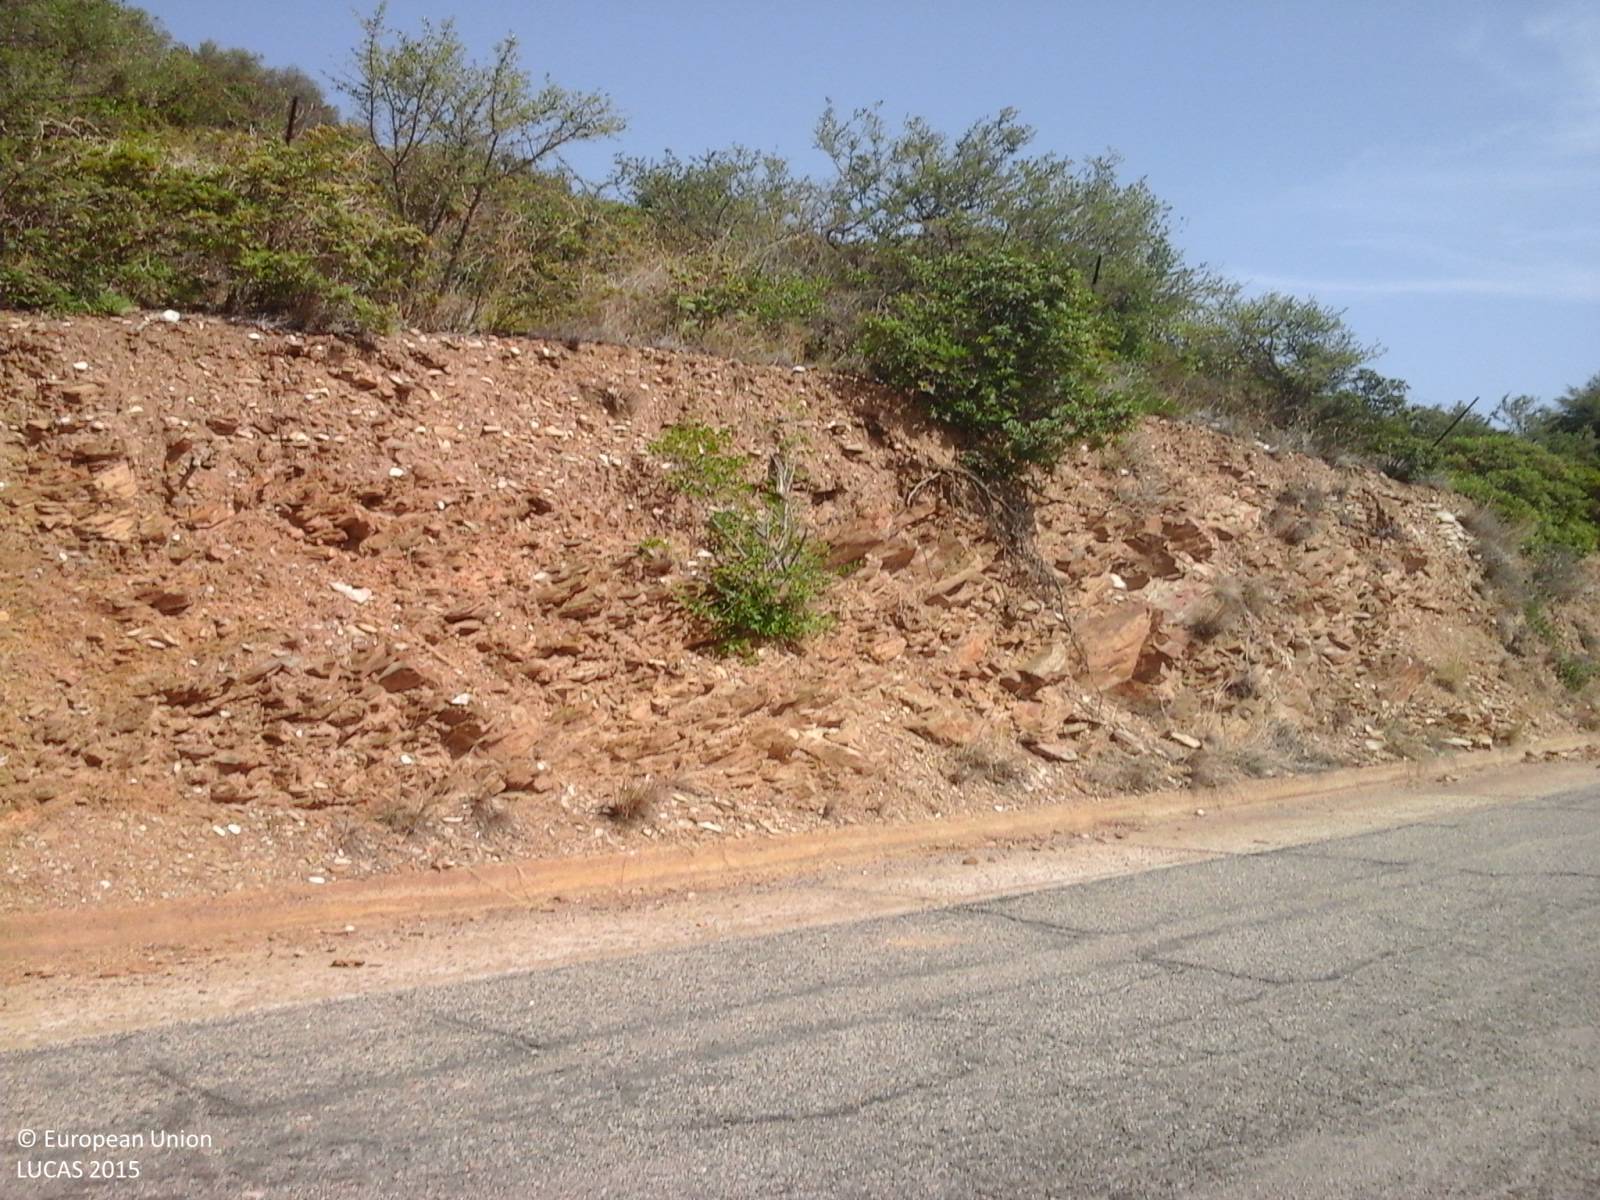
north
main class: Woodland
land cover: Broadleaved woodland
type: broadleaved evergreen forest
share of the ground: > 75 %
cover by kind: broadleaved forest trees 50 %, shrubs 20 %, unconsolidated bare surface 20 %, herbaceous plants 10 %
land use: Semi-natural and natural areas not in use
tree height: > 5 m
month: September
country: IT
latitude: 39.9952
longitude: 9.6855
